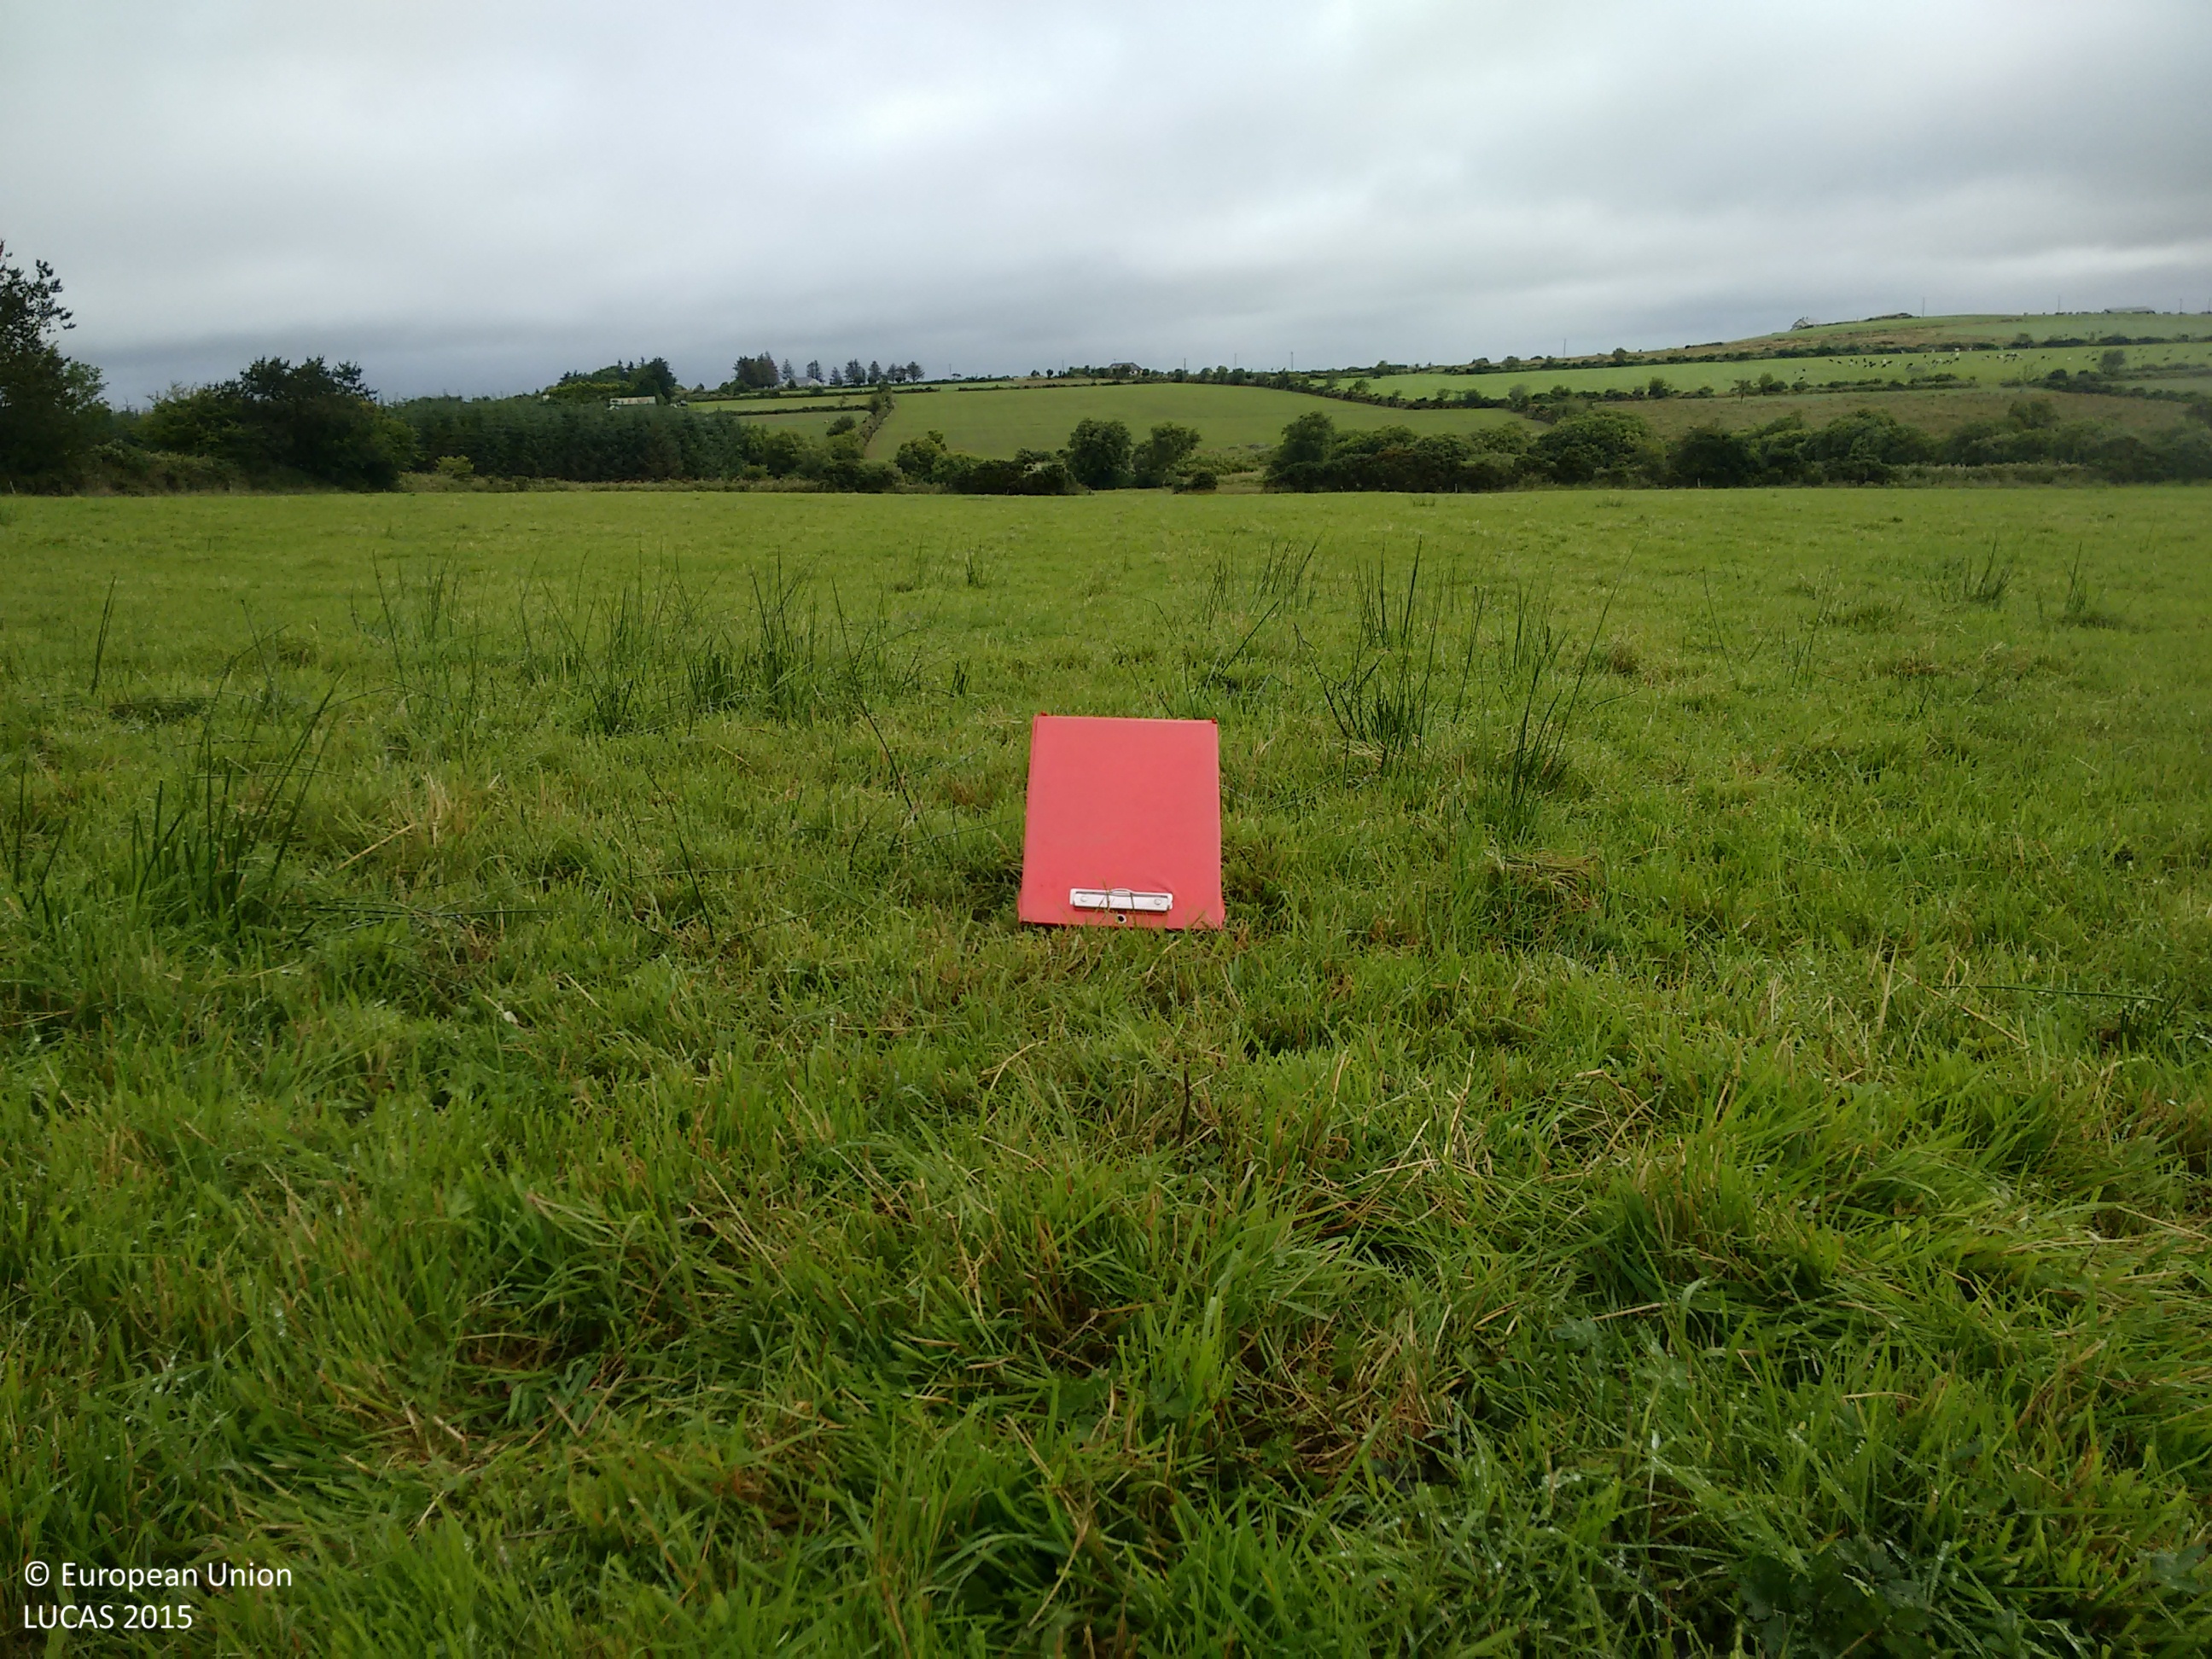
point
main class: Grassland
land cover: Grassland without tree/shrub cover
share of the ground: > 75 %
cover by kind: herbaceous plants 100 %
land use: Agriculture (excluding fallow land and kitchen gardens)
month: July
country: IE
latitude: 52.0859
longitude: -8.3885
